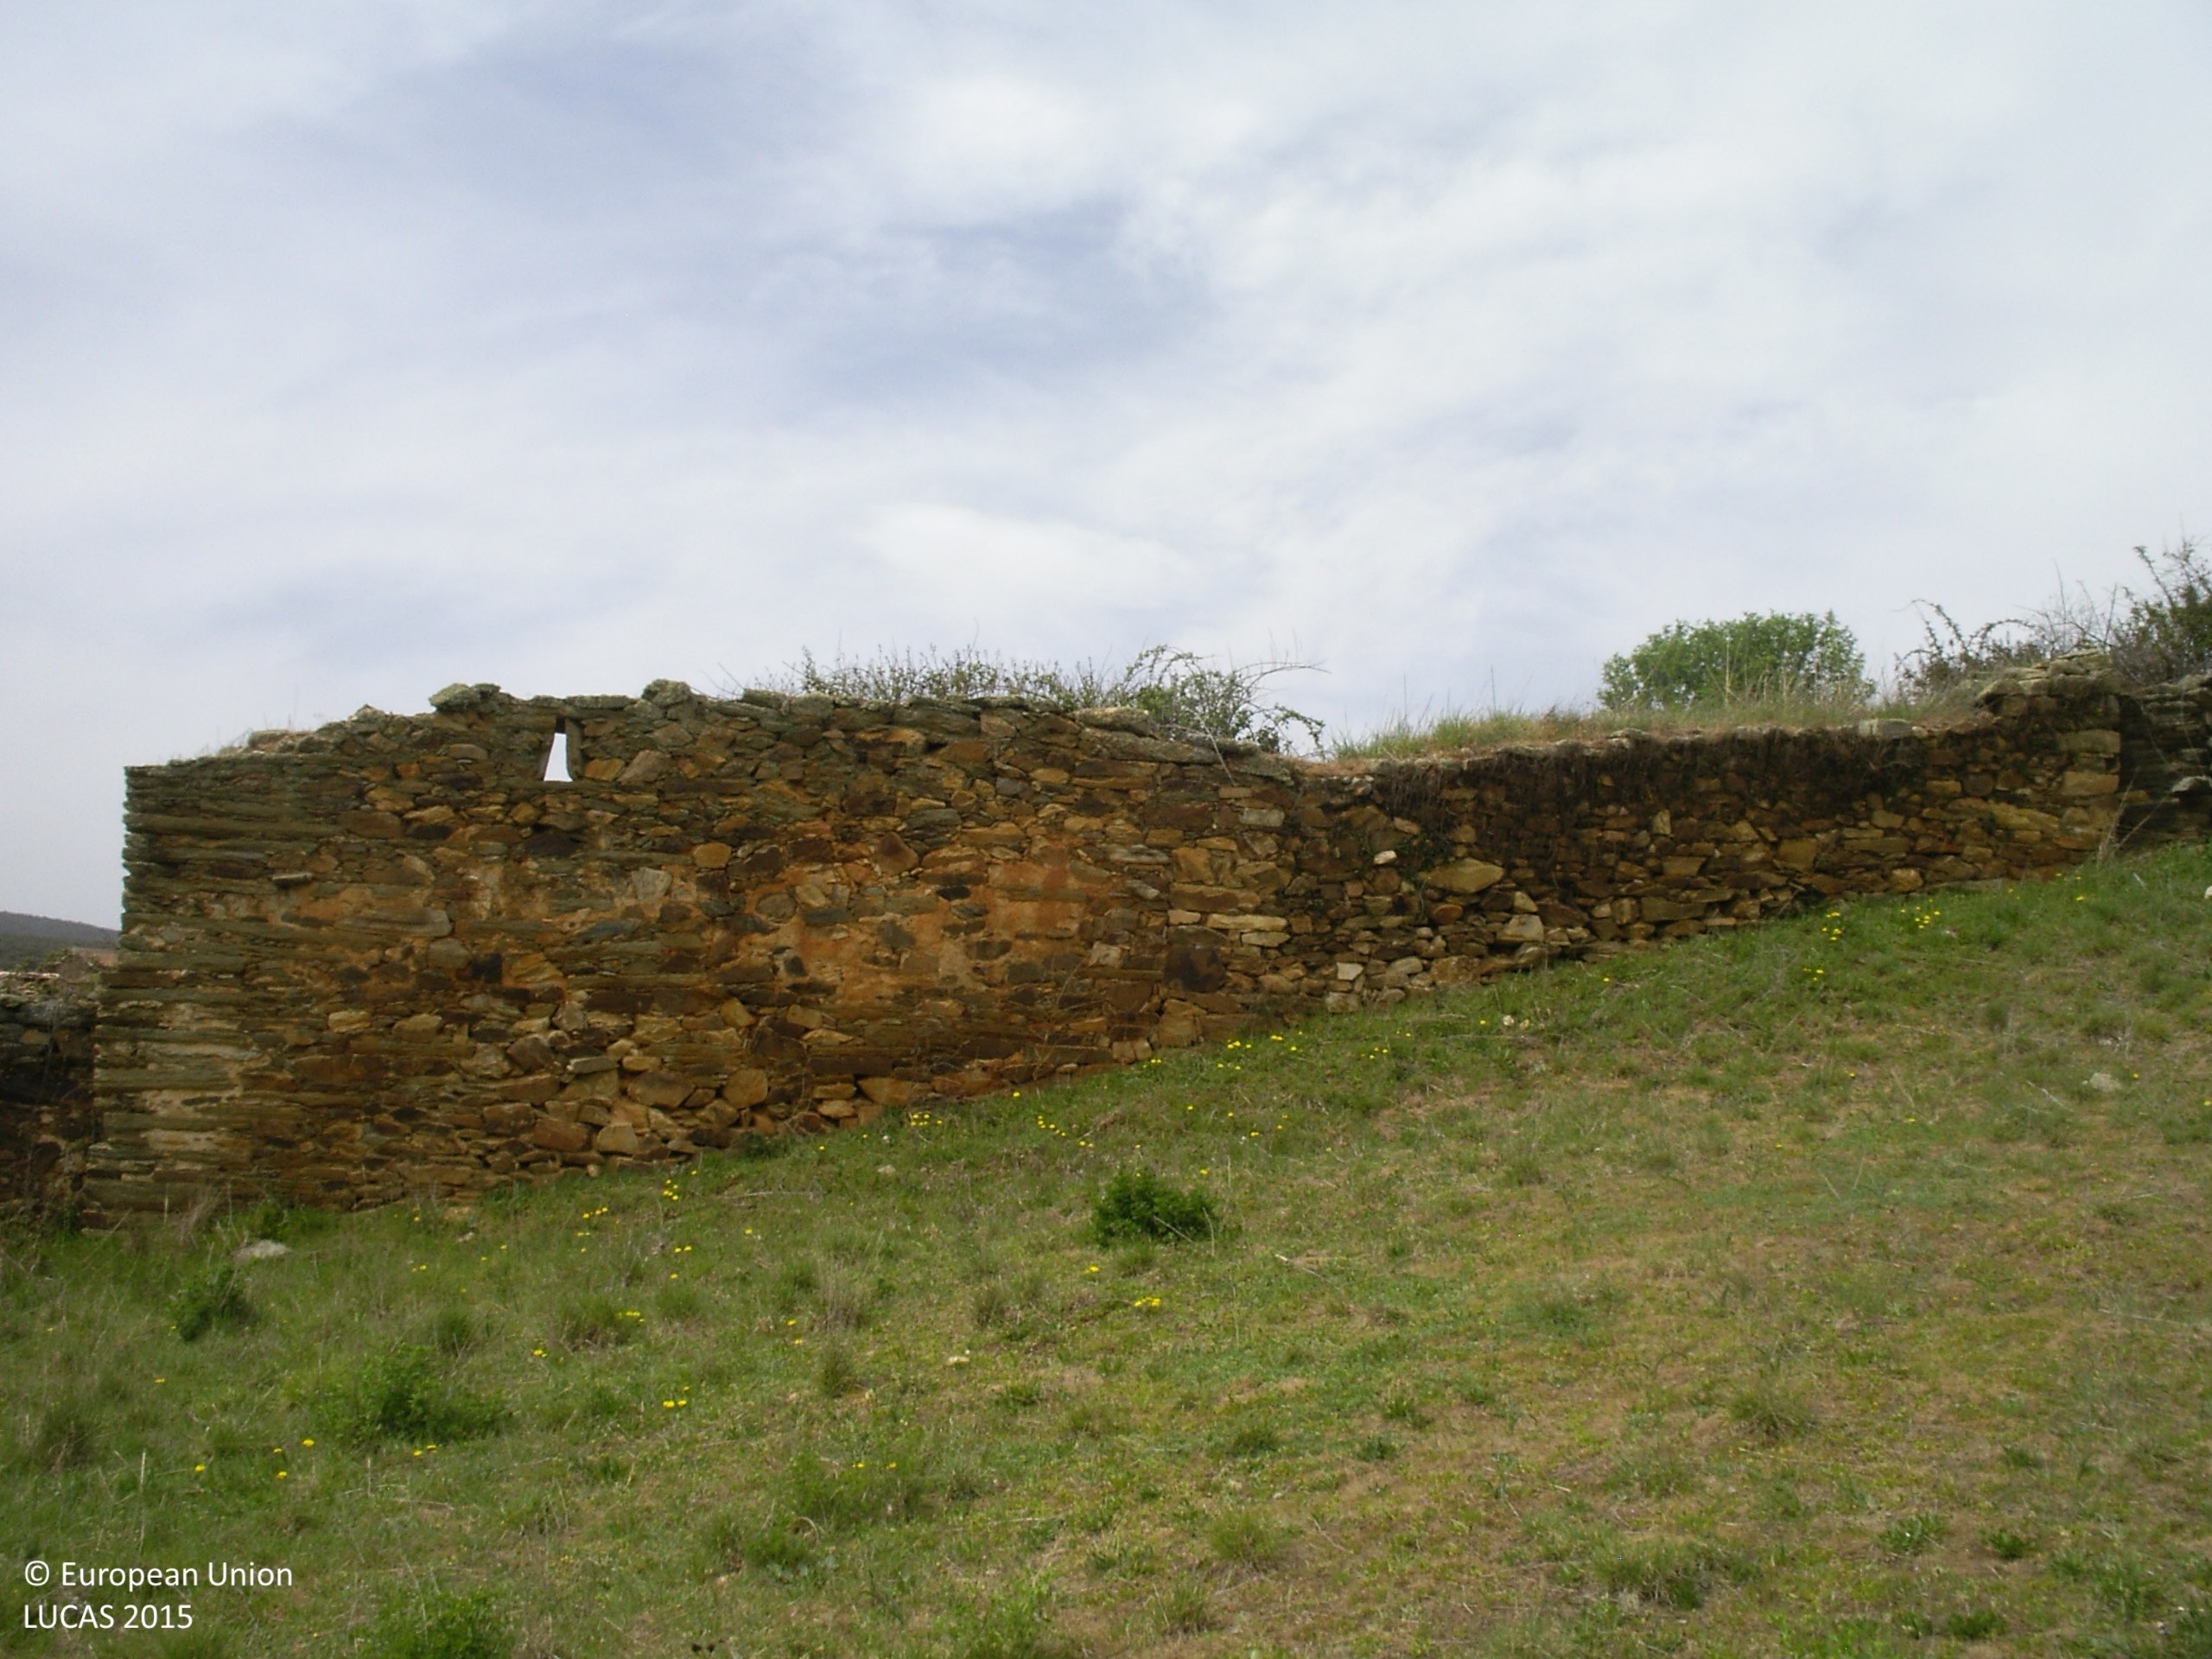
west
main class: Grassland
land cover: Grassland without tree/shrub cover
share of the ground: > 75 %
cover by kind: herbaceous plants 95 %, shrubs 5 %
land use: Abandoned areas
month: April
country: ES
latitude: 42.3849
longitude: -6.1026
